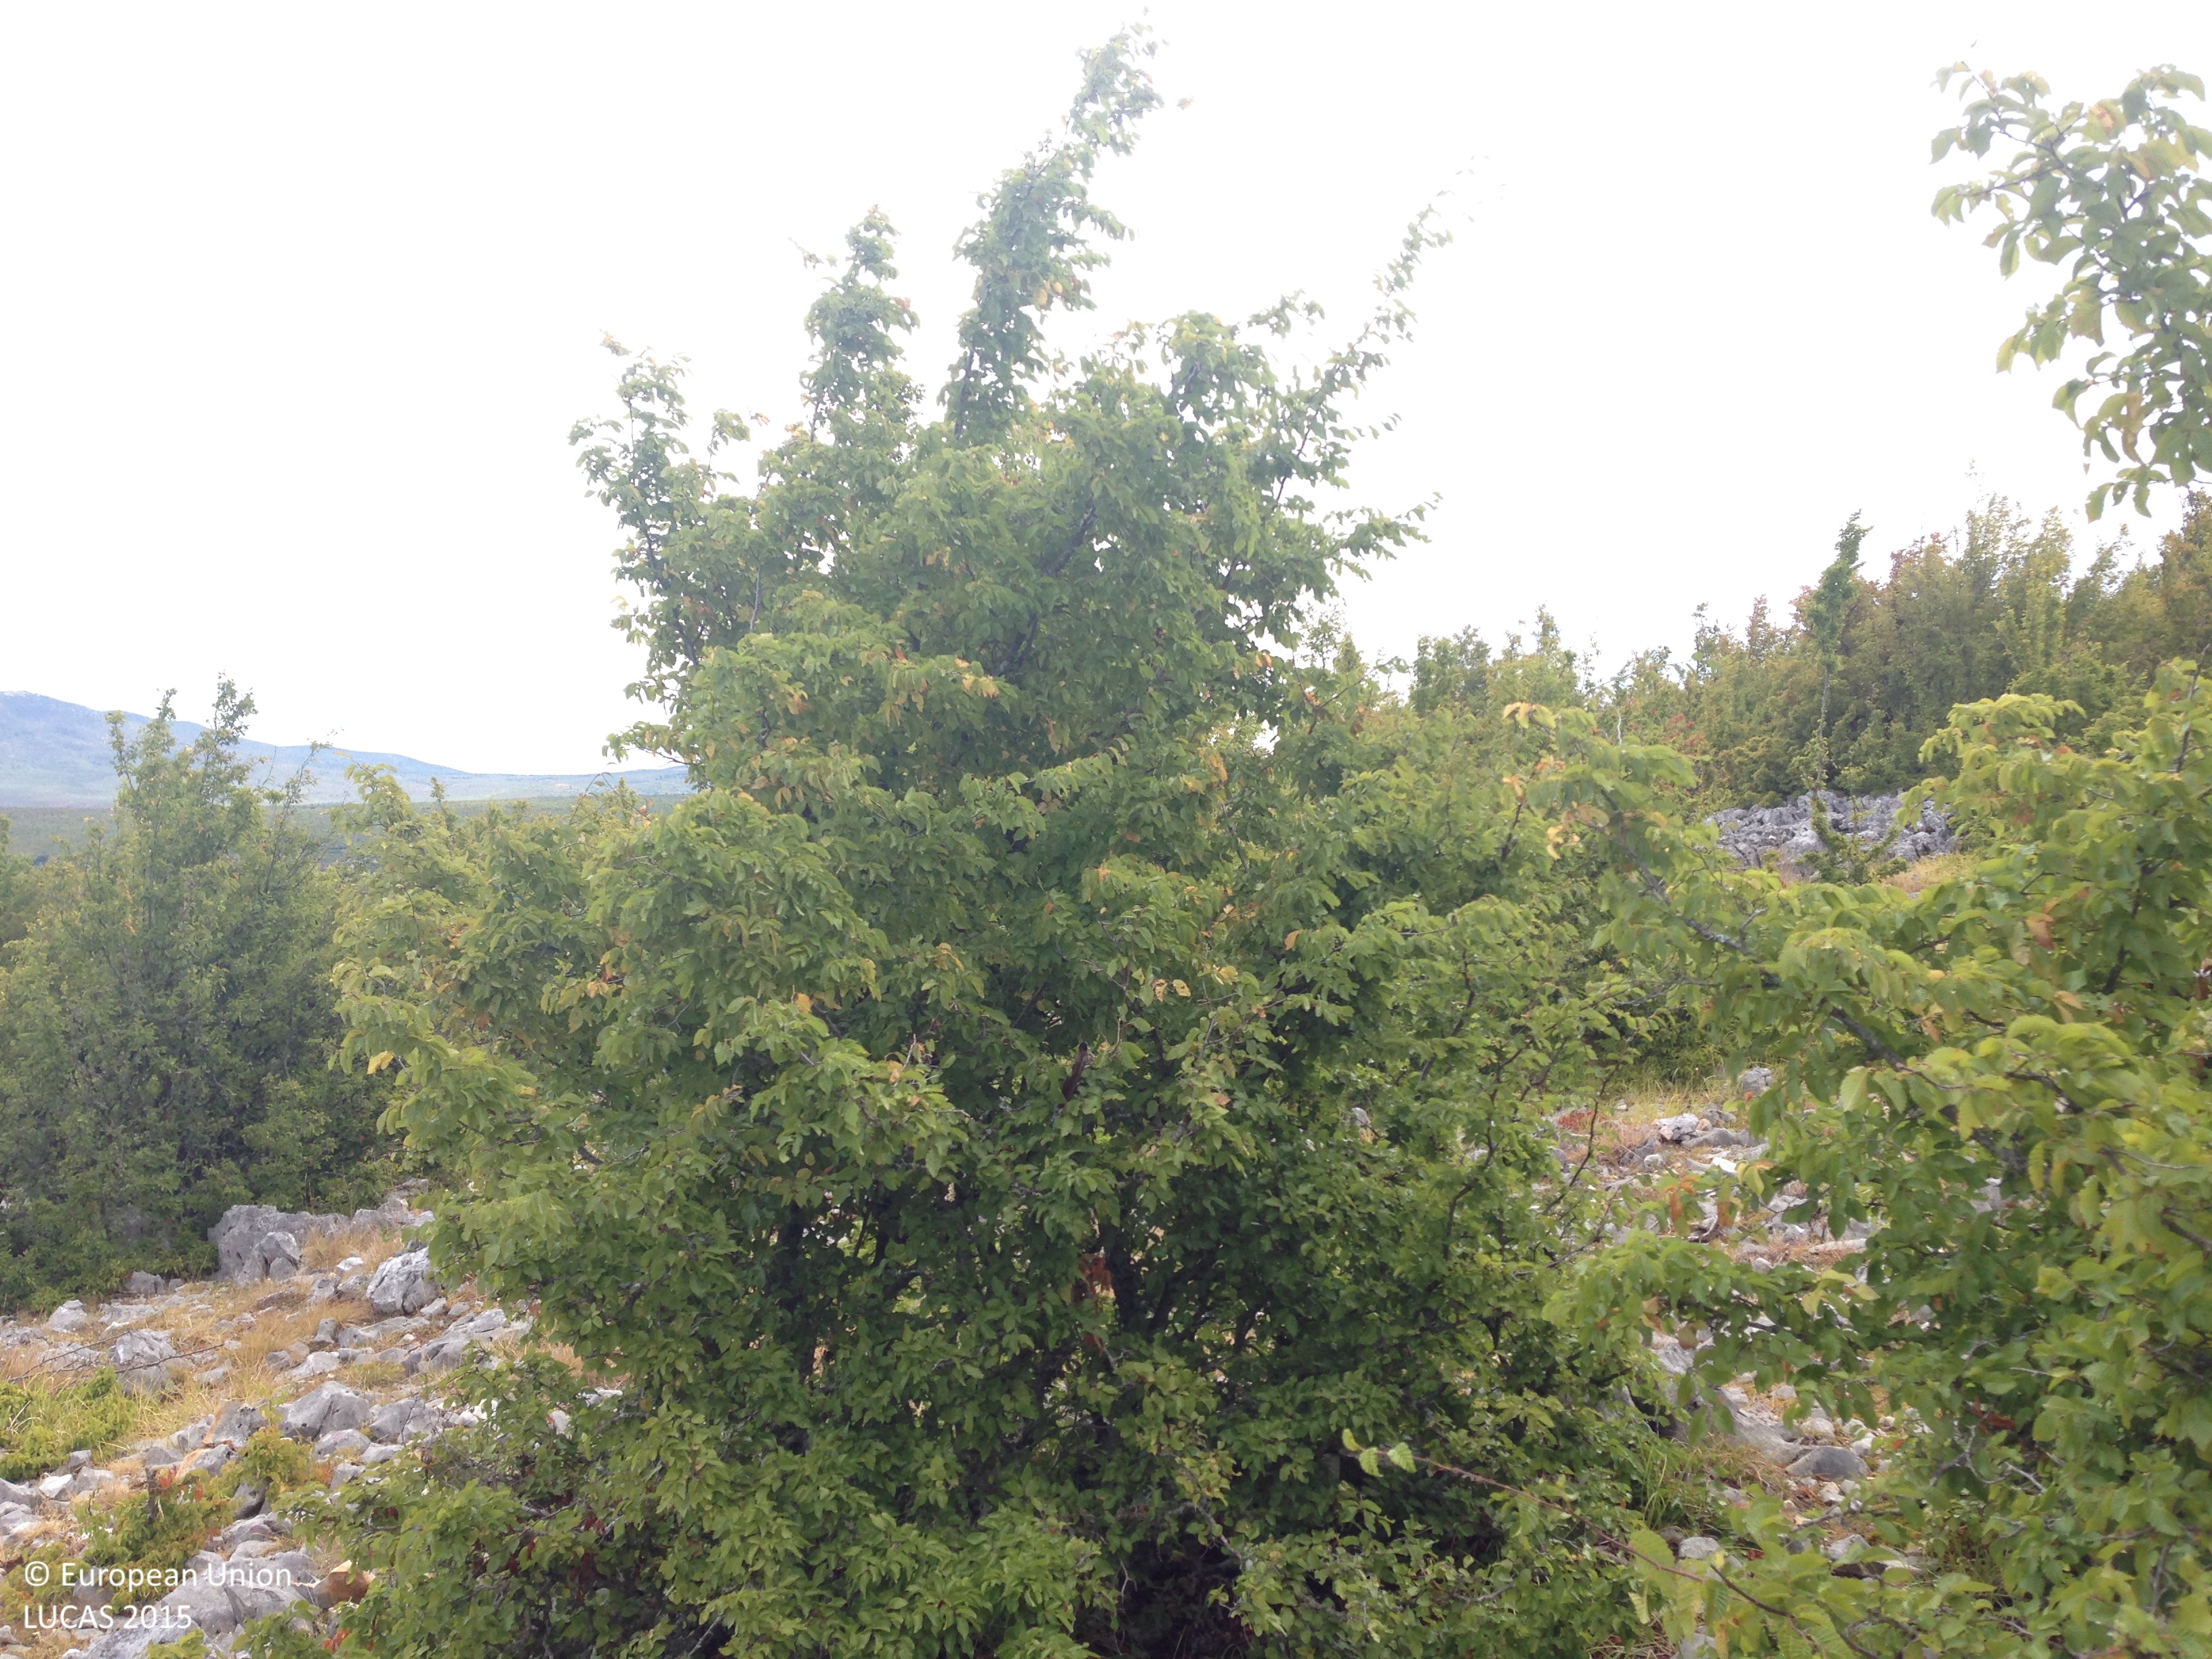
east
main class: Woodland
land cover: Broadleaved woodland
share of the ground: 50 - 75 %
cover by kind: broadleaved forest trees 55 %, unconsolidated bare surface 15 %, shrubs 10 %, herbaceous plants 10 %, consolidated bare surface 10 %
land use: Semi-natural and natural areas not in use
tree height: < 5 m
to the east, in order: Broadleaved woodland; Tracks; Broadleaved woodland; Tracks; Broadleaved woodland; Tracks; Broadleaved woodland
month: July
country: HR
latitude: 44.1490
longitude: 15.8560
